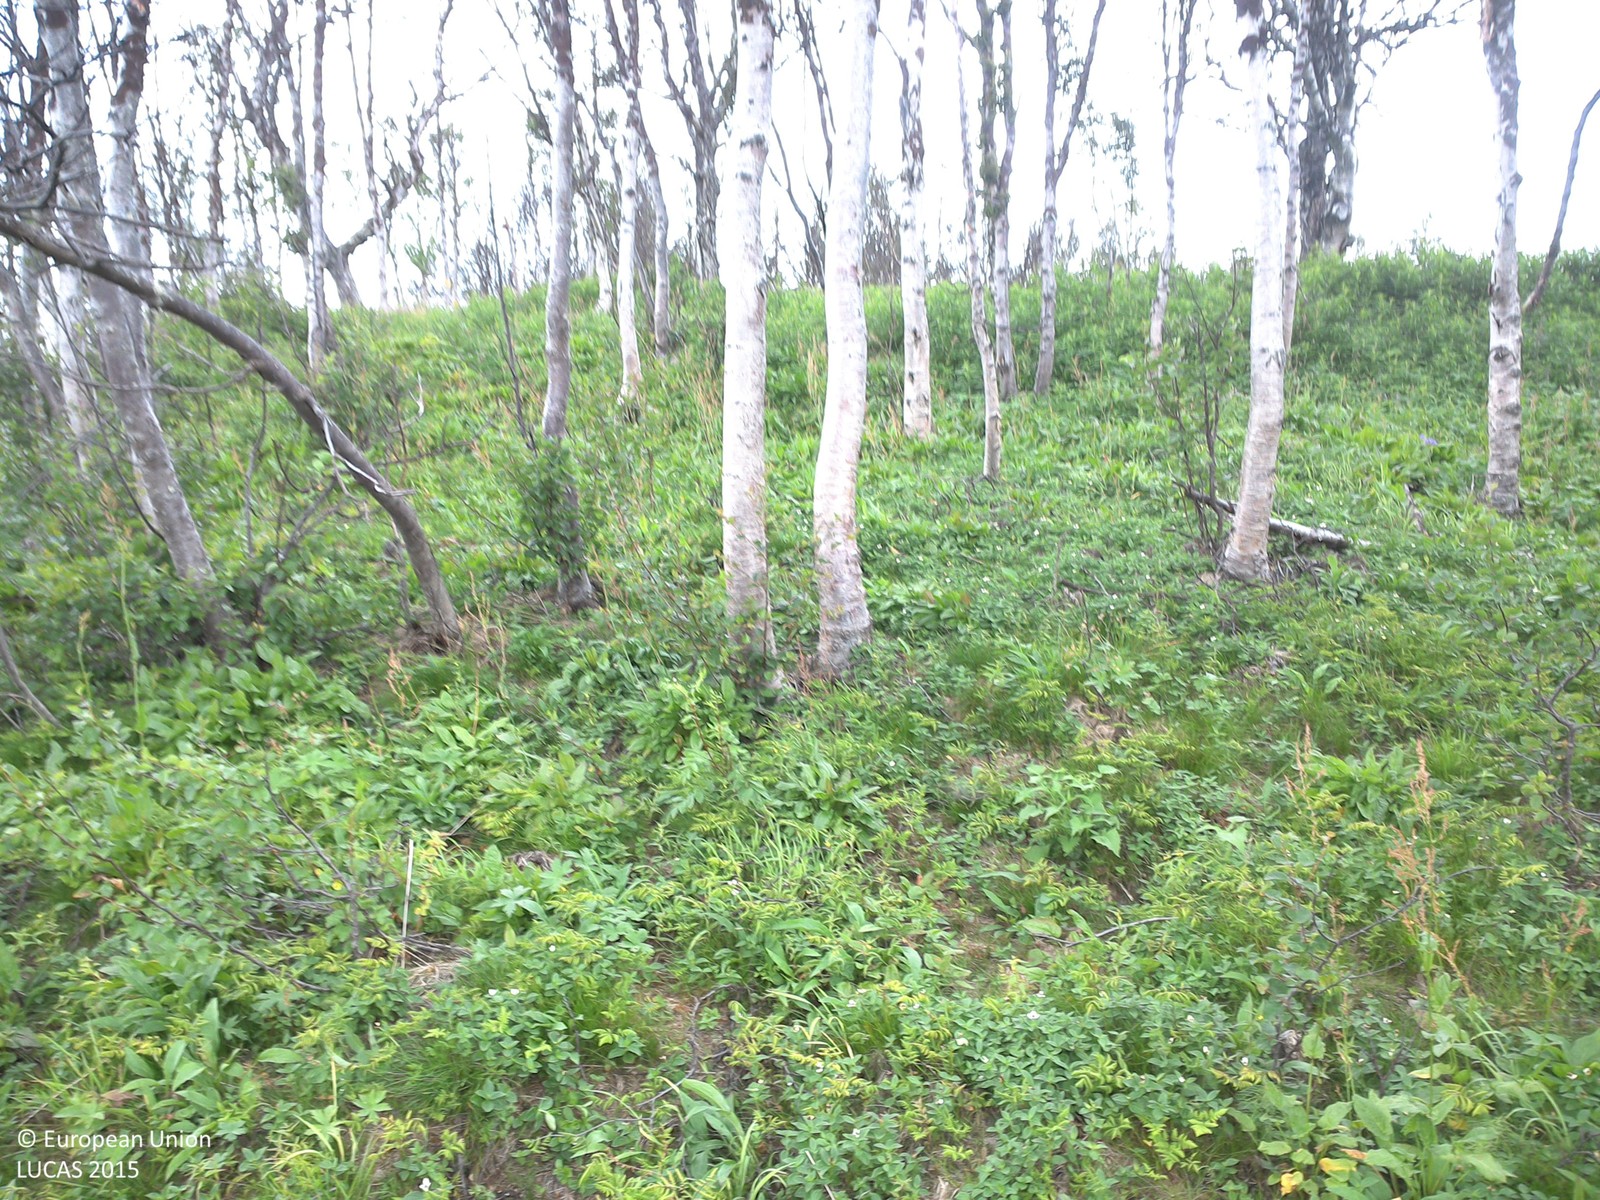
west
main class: Woodland
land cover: Broadleaved woodland
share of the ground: 25 - 50 %
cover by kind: herbaceous plants 75 %, broadleaved forest trees 25 %
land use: Amenities, museums, leisure
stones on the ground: < 10 %
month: August
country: SE
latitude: 68.4069
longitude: 18.6729
